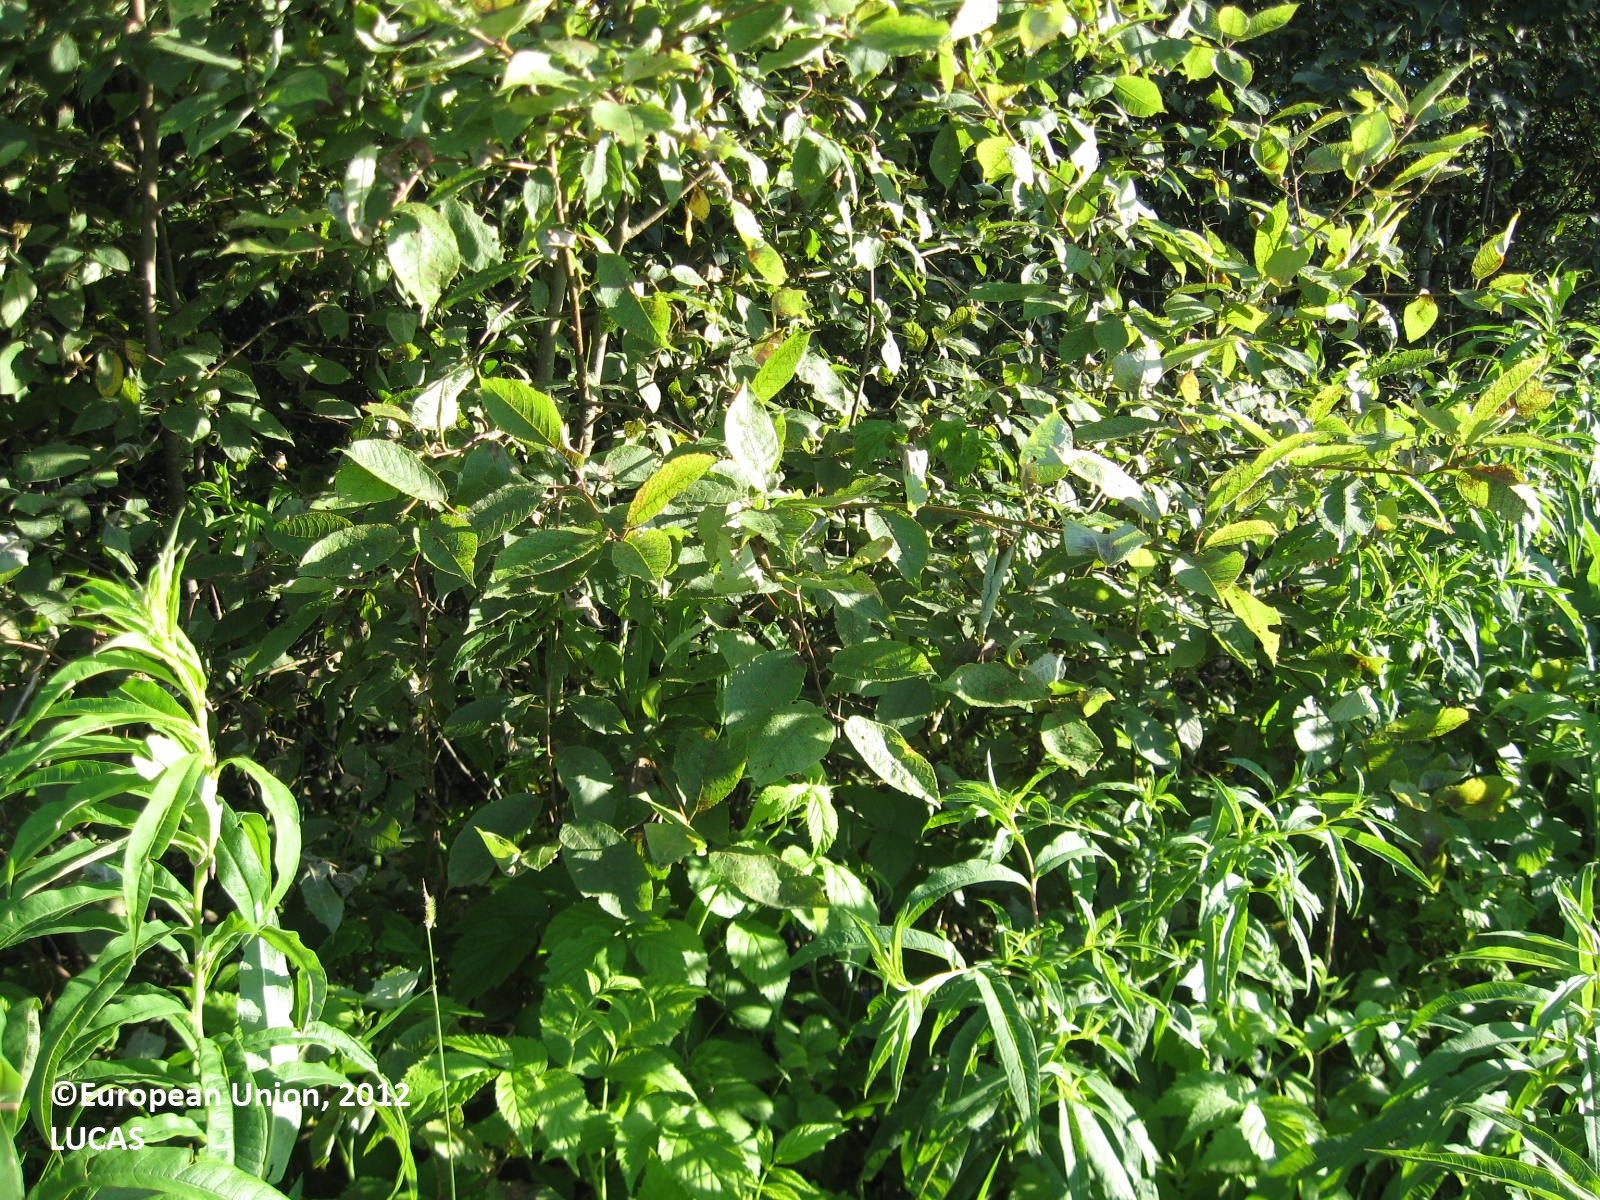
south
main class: Cropland
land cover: Barley
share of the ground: > 75 %
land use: Agriculture (excluding fallow land and kitchen gardens)
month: July
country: FI
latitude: 62.0725
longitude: 22.4802
